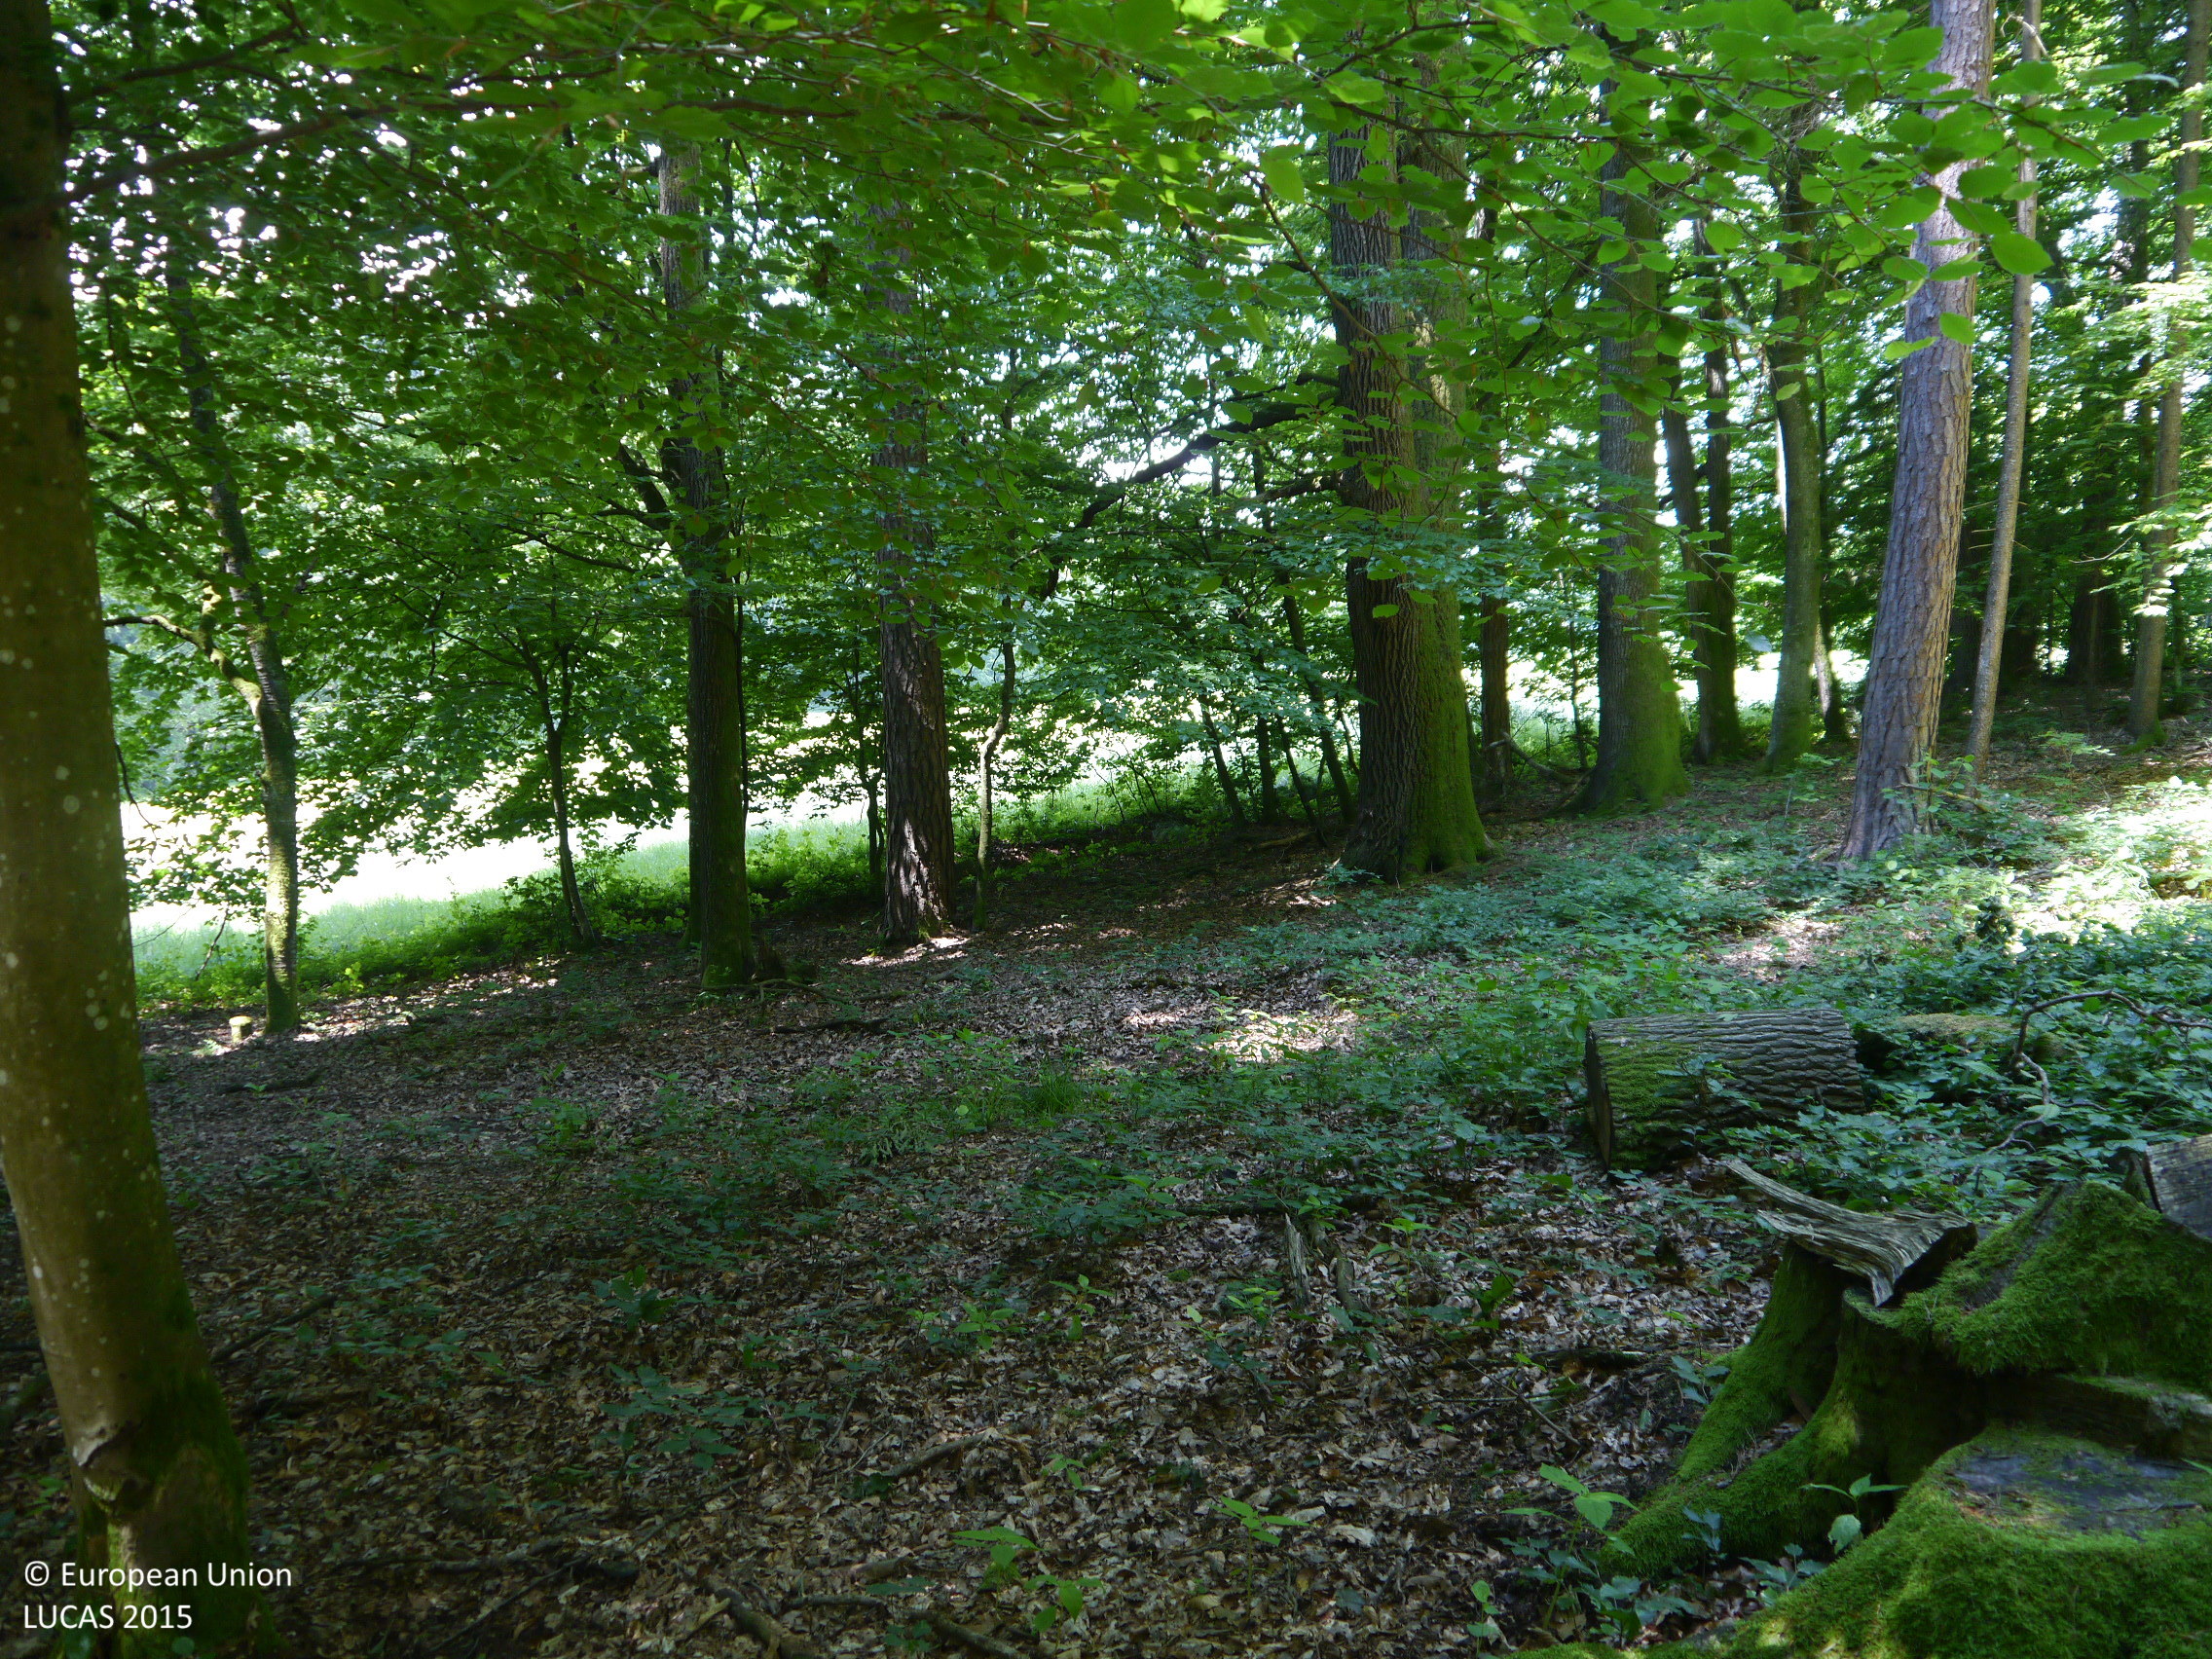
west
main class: Woodland
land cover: Other mixed woodland
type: mountainous beech forest
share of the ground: > 75 %
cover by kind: broadleaved forest trees 70 %, coniferous forest trees 30 %
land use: Forestry
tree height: > 5 m
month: June
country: AT
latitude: 46.9055
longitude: 15.6581
